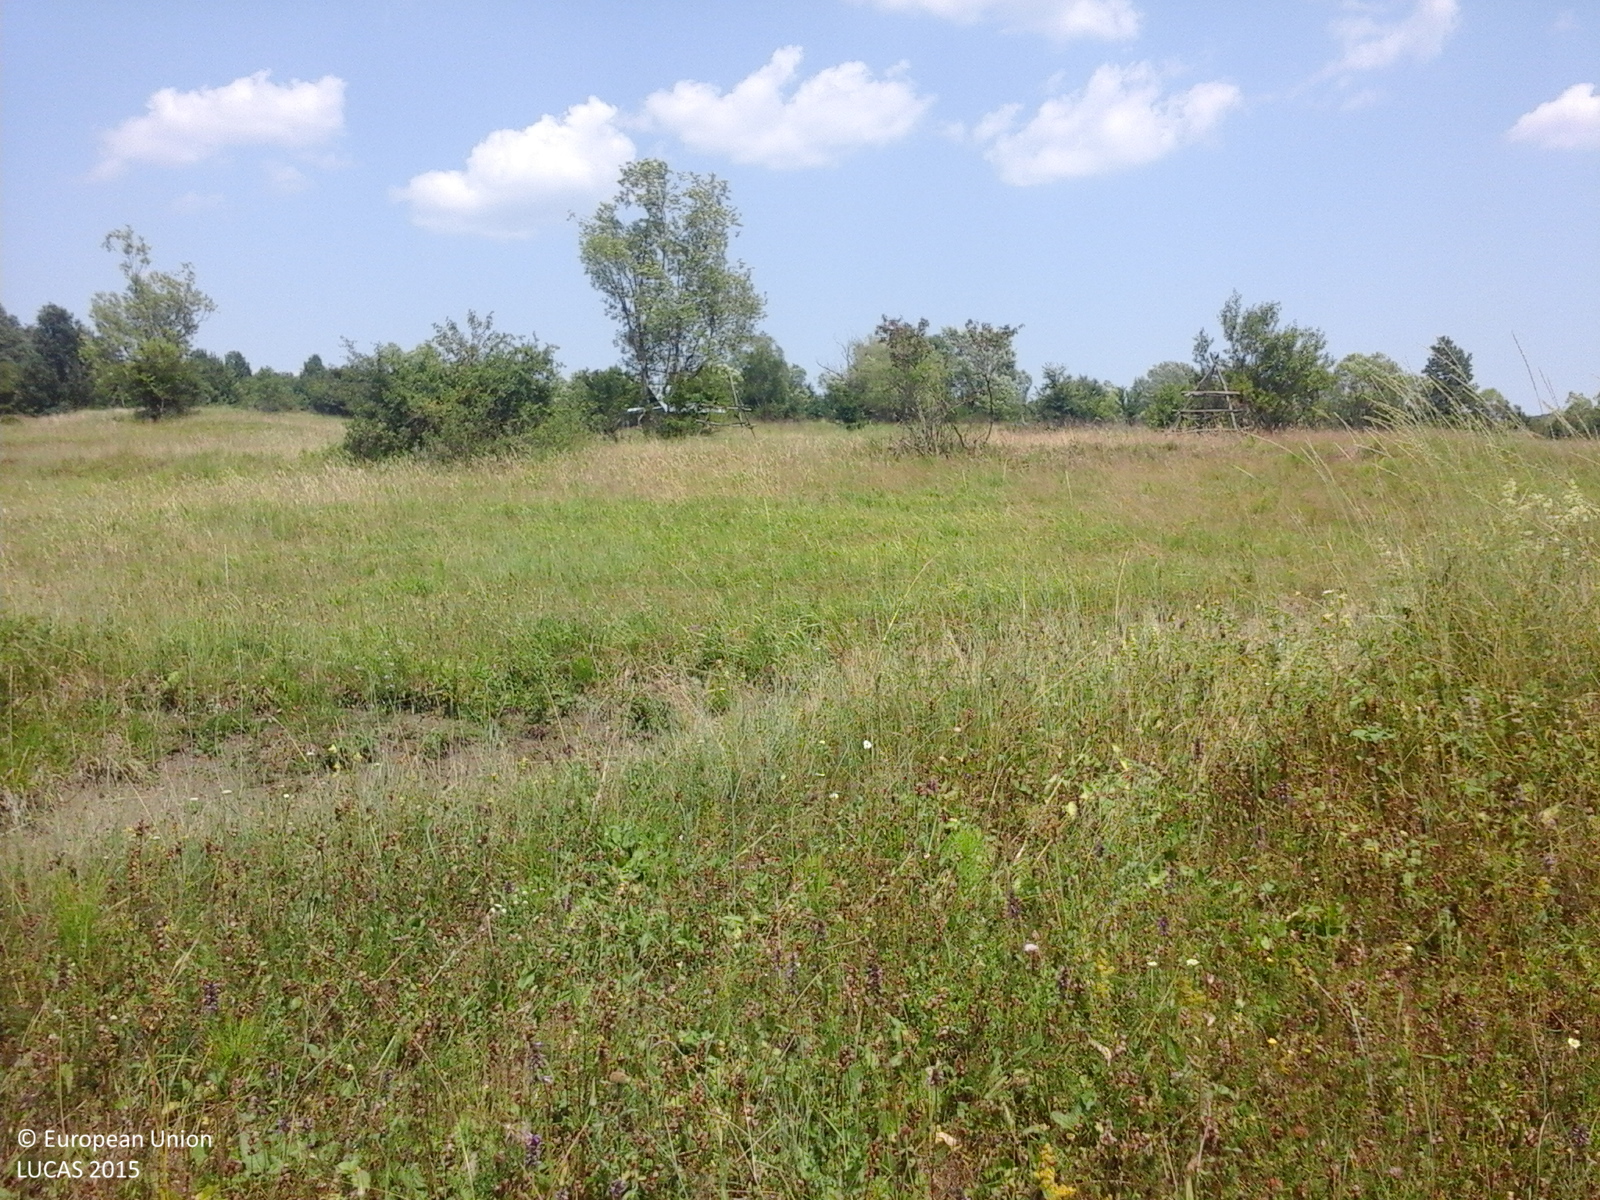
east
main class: Grassland
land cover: Grassland without tree/shrub cover
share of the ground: > 75 %
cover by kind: herbaceous plants 100 %
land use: Agriculture (excluding fallow land and kitchen gardens)
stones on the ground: < 10 %
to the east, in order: Grassland without tree/shrub cover; Tracks; Grassland without tree/shrub cover; Spontaneously vegetated surfaces; Grassland with sparse tree/shrub cover; Spontaneously vegetated surfaces
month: July
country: RO
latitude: 45.1572
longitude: 24.6188
